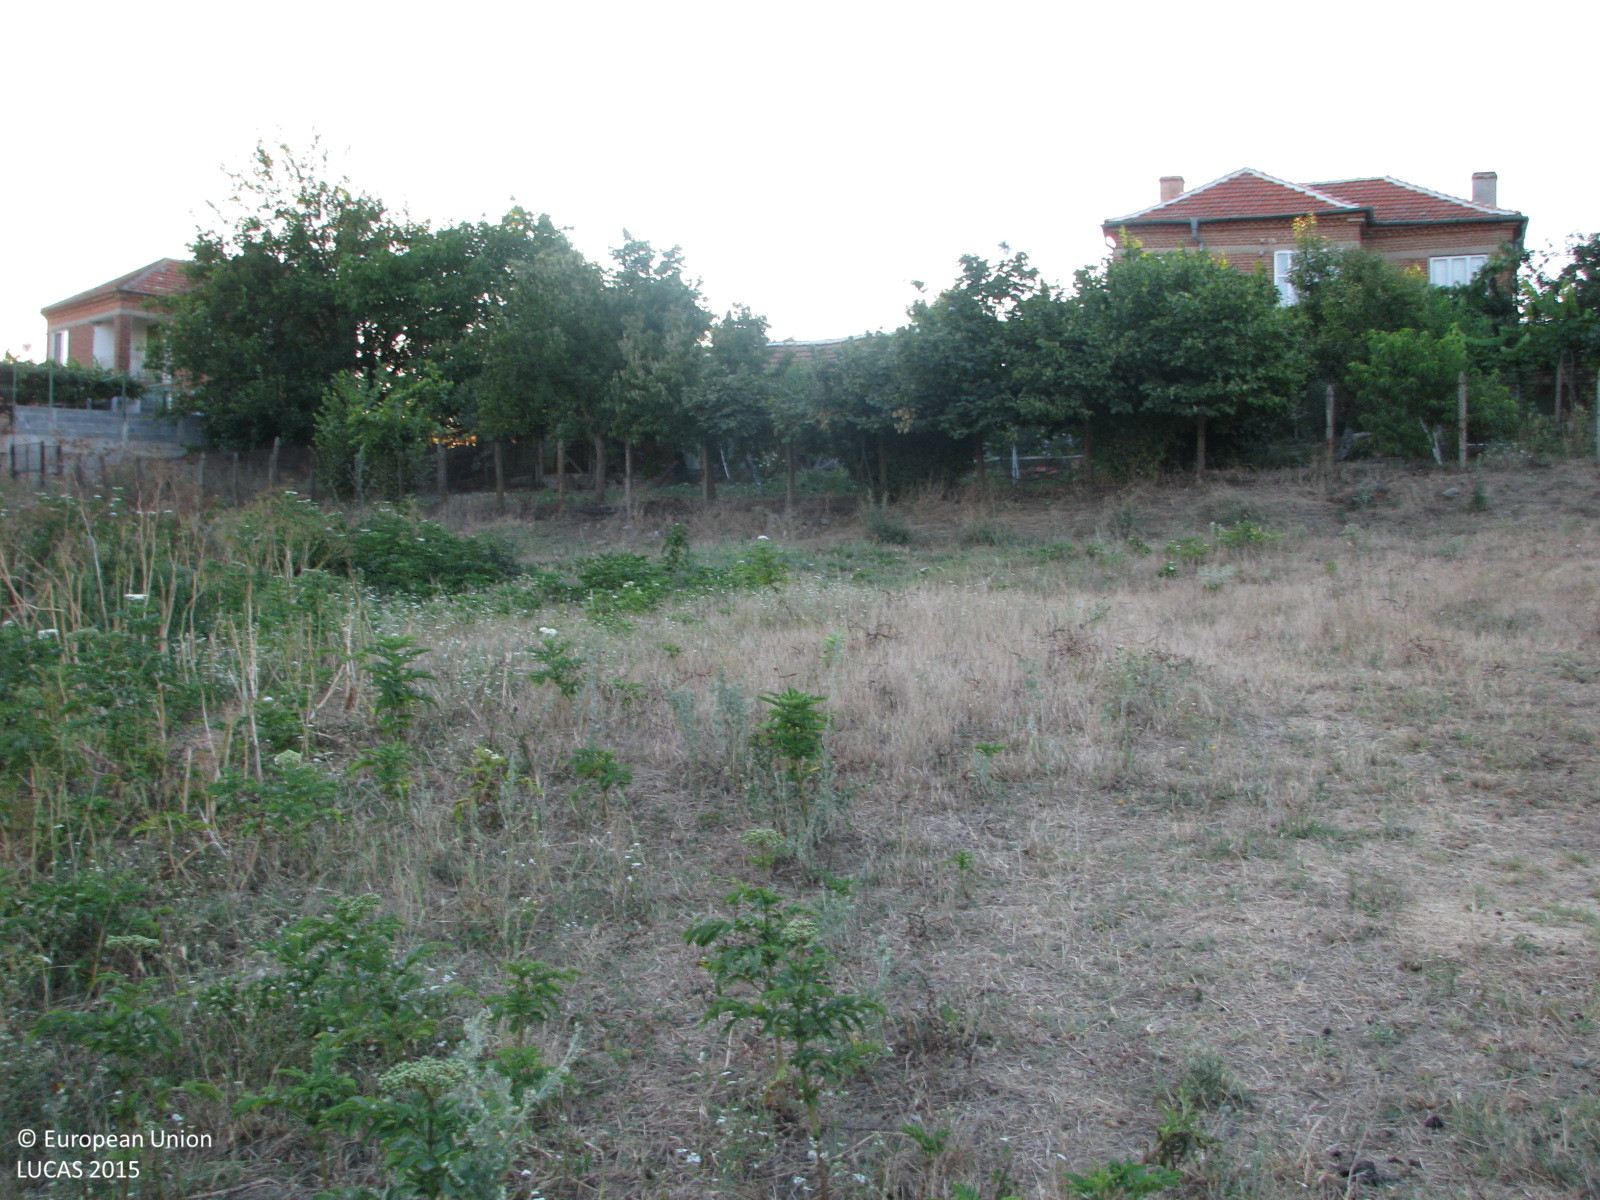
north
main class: Grassland
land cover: Grassland without tree/shrub cover
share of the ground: > 75 %
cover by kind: herbaceous plants 80 %, unconsolidated bare surface 20 %
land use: Agriculture (excluding fallow land and kitchen gardens)
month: July
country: BG
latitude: 42.1943
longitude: 26.9188
